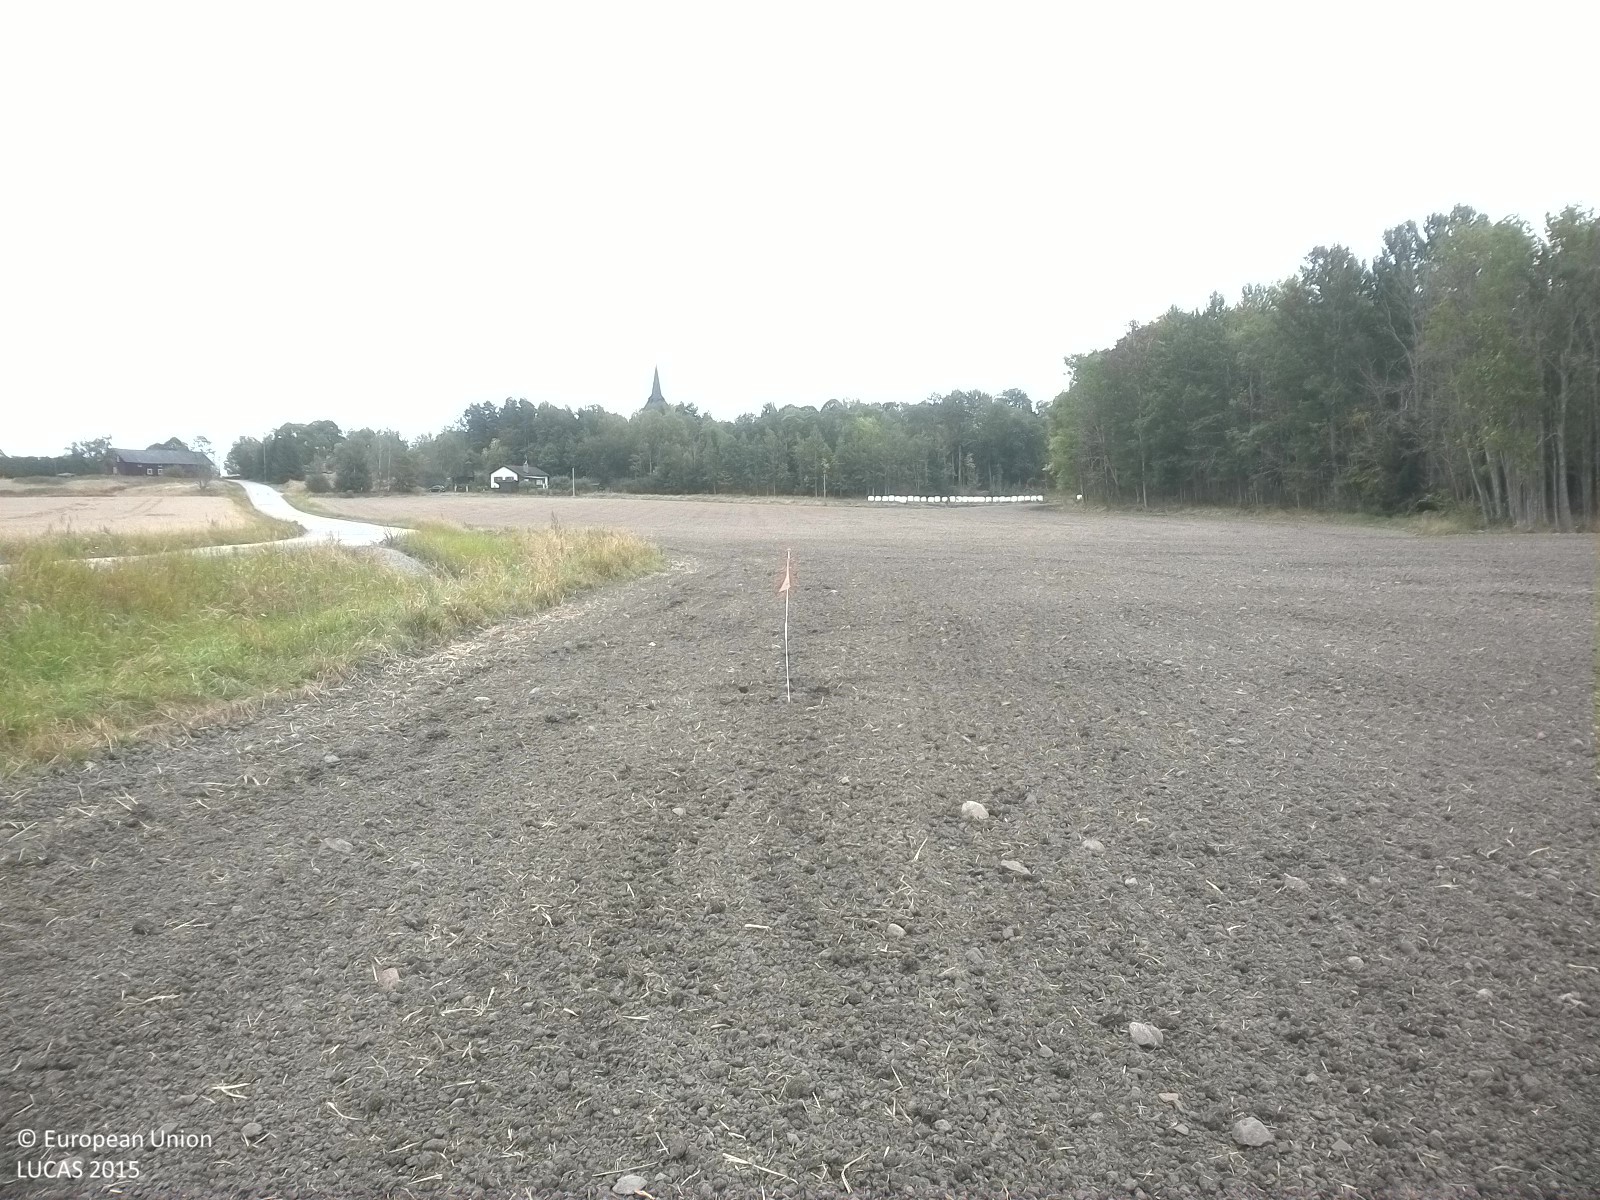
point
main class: Cropland
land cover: Common wheat
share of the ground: < 10 %
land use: Agriculture (excluding fallow land and kitchen gardens)
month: September
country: SE
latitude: 58.5574
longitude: 16.3376
